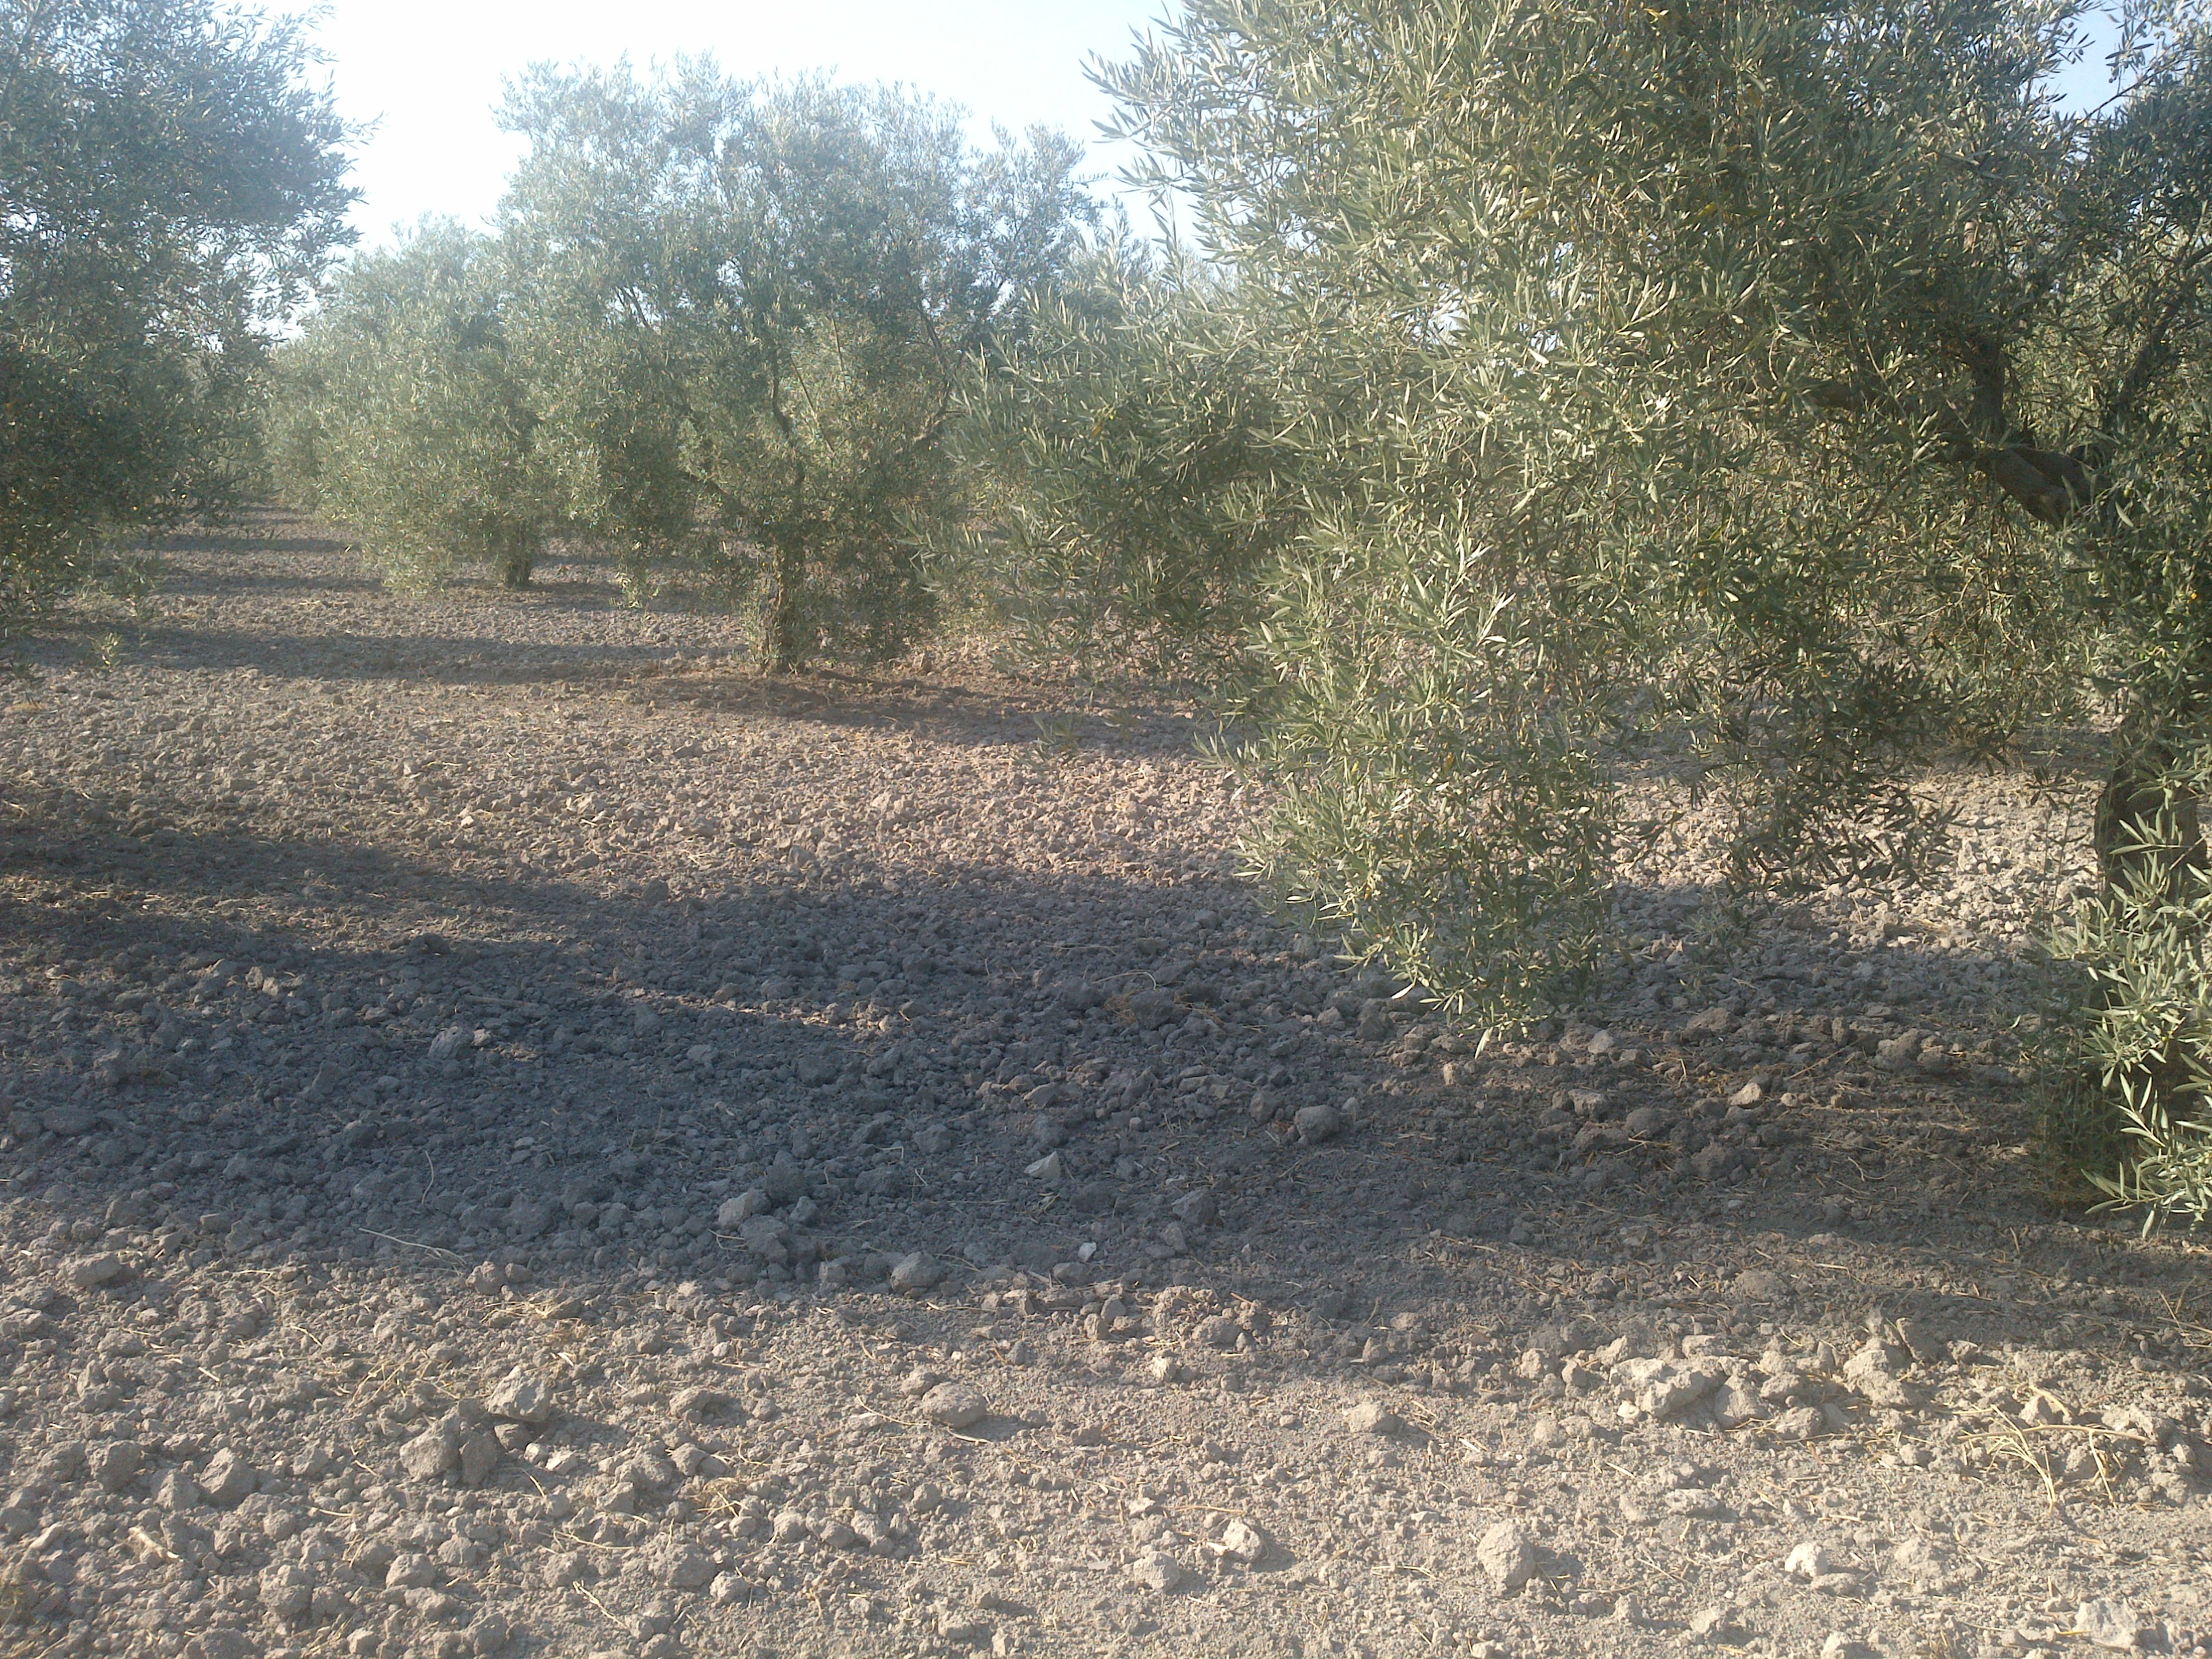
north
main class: Cropland
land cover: Olive groves
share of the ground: 25 - 50 %
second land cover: Other bare soil
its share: > 75 %
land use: Agriculture (excluding fallow land and kitchen gardens)
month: June
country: ES
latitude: 37.3746
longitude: -4.5591
